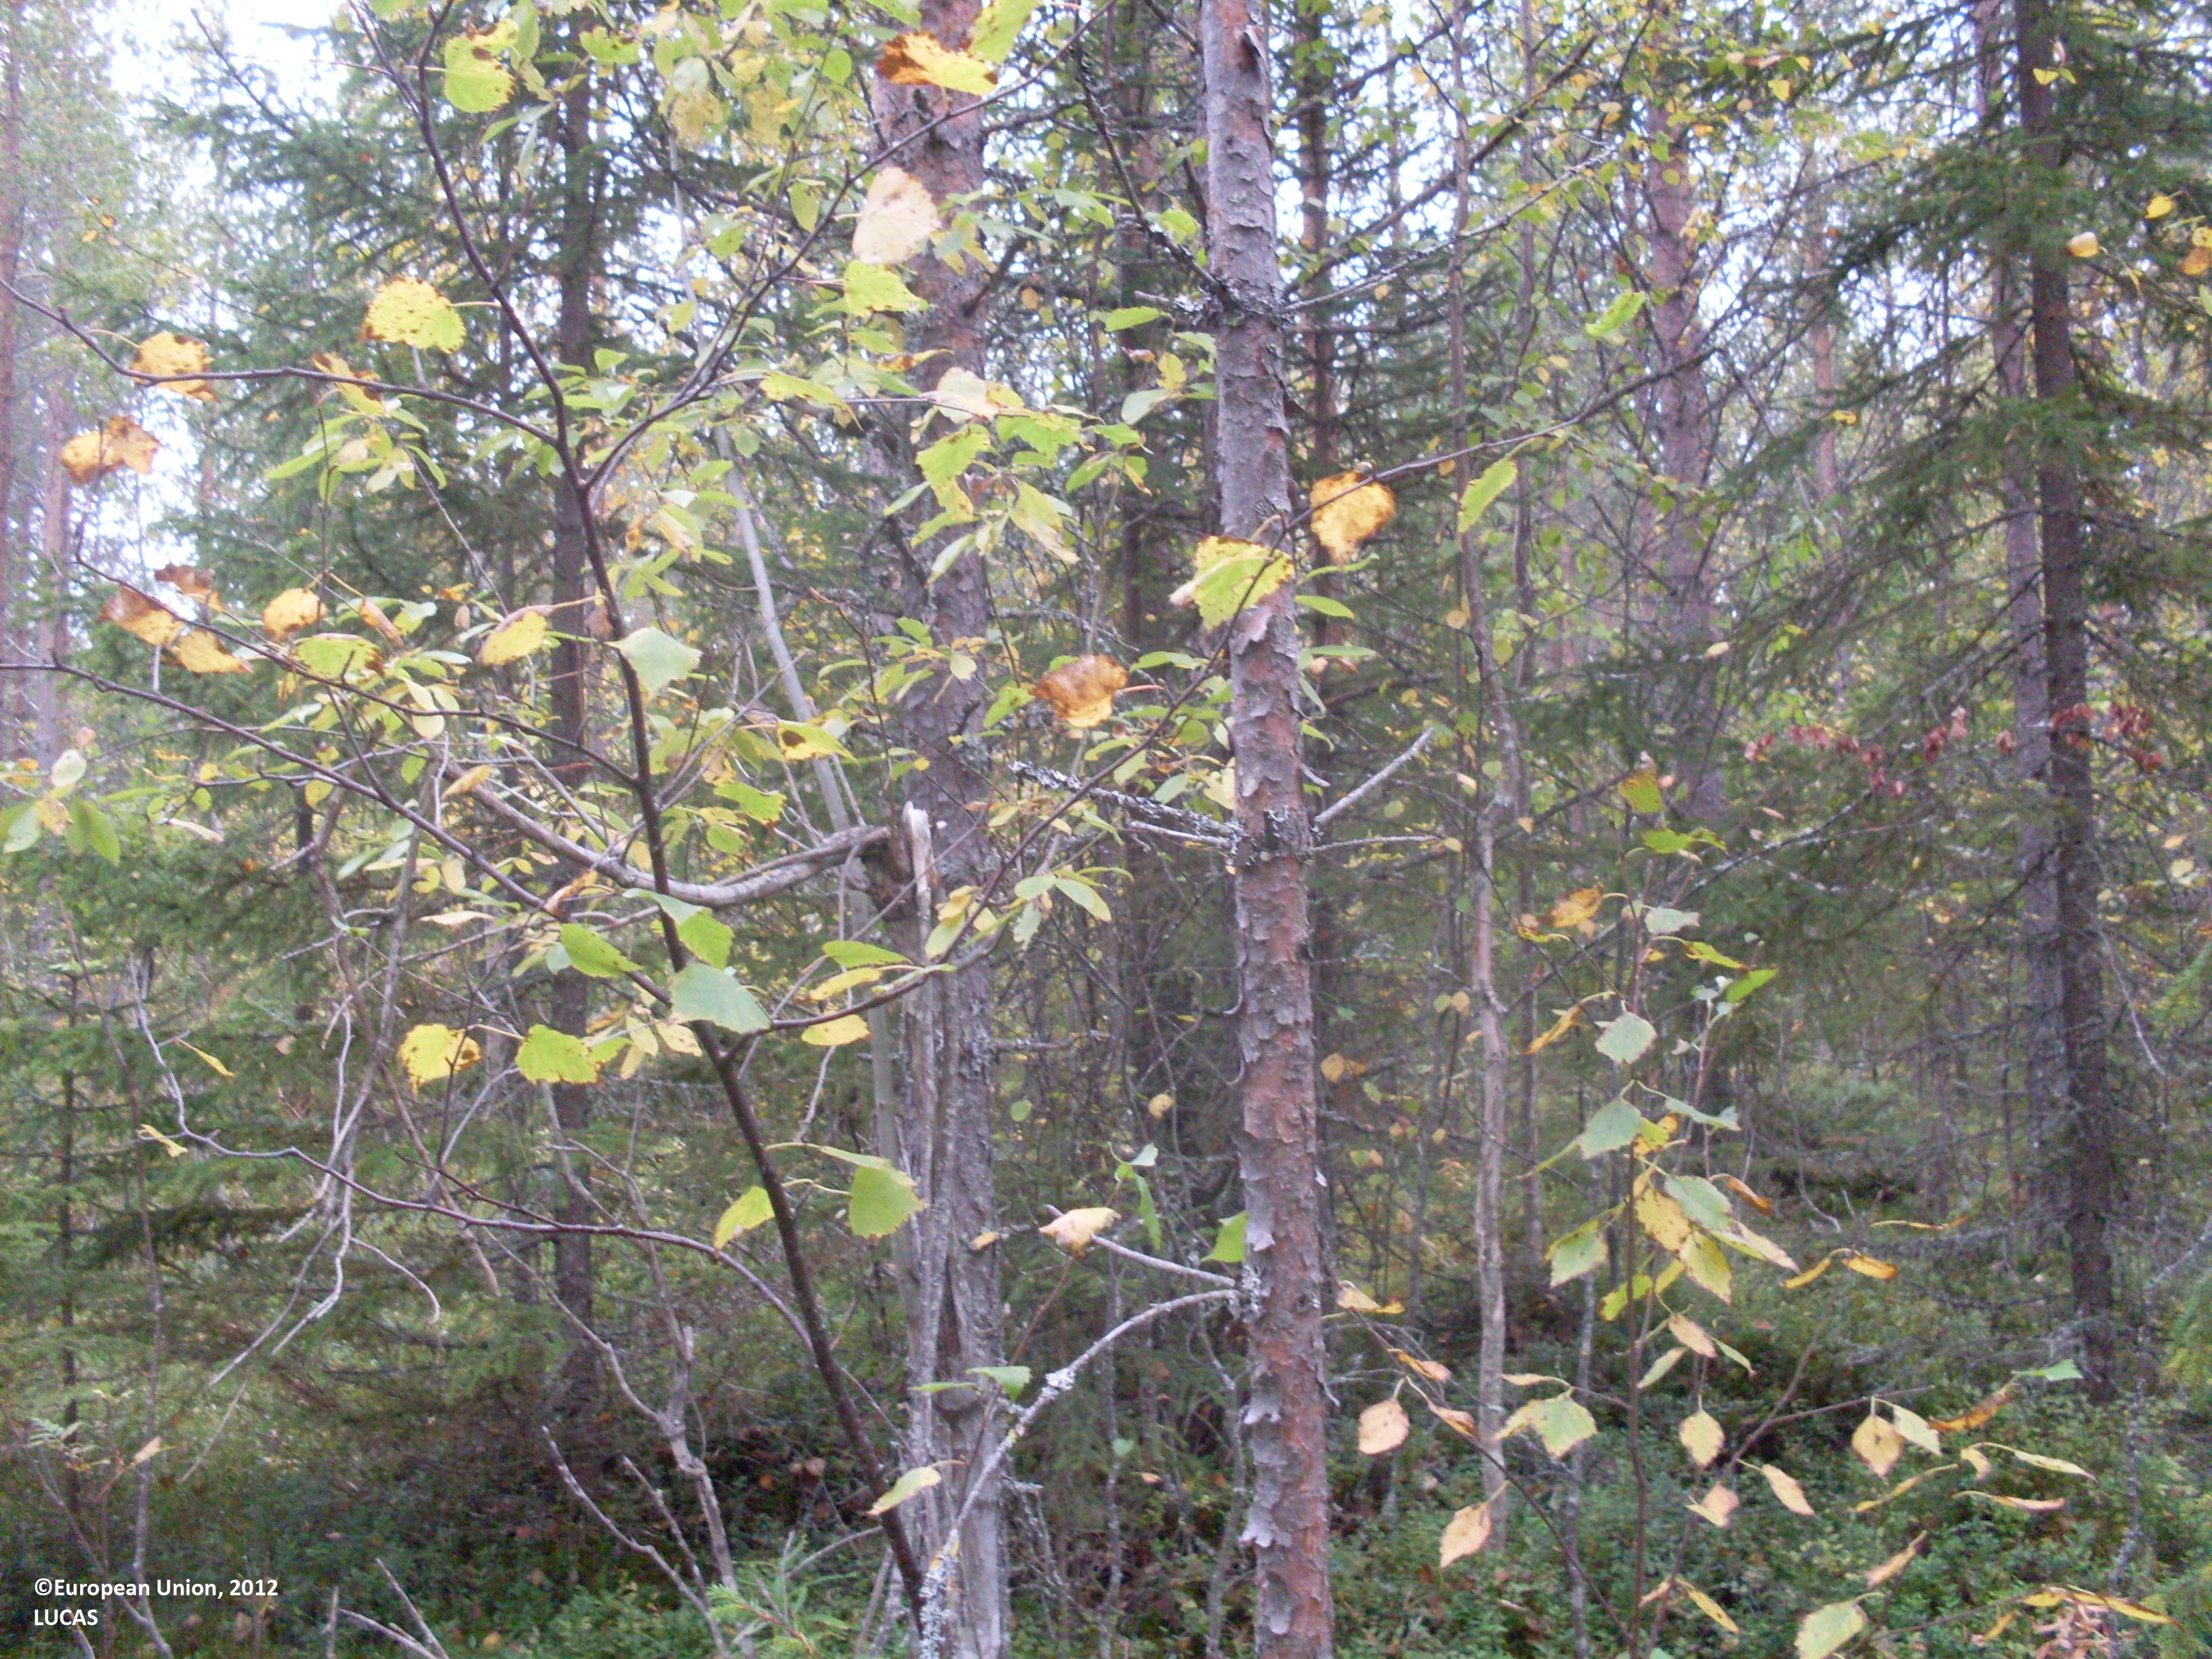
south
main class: Woodland
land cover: Other mixed woodland
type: boreal forest
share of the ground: > 75 %
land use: Forestry
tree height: > 5 m
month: September
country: FI
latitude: 63.9992
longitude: 29.8841
